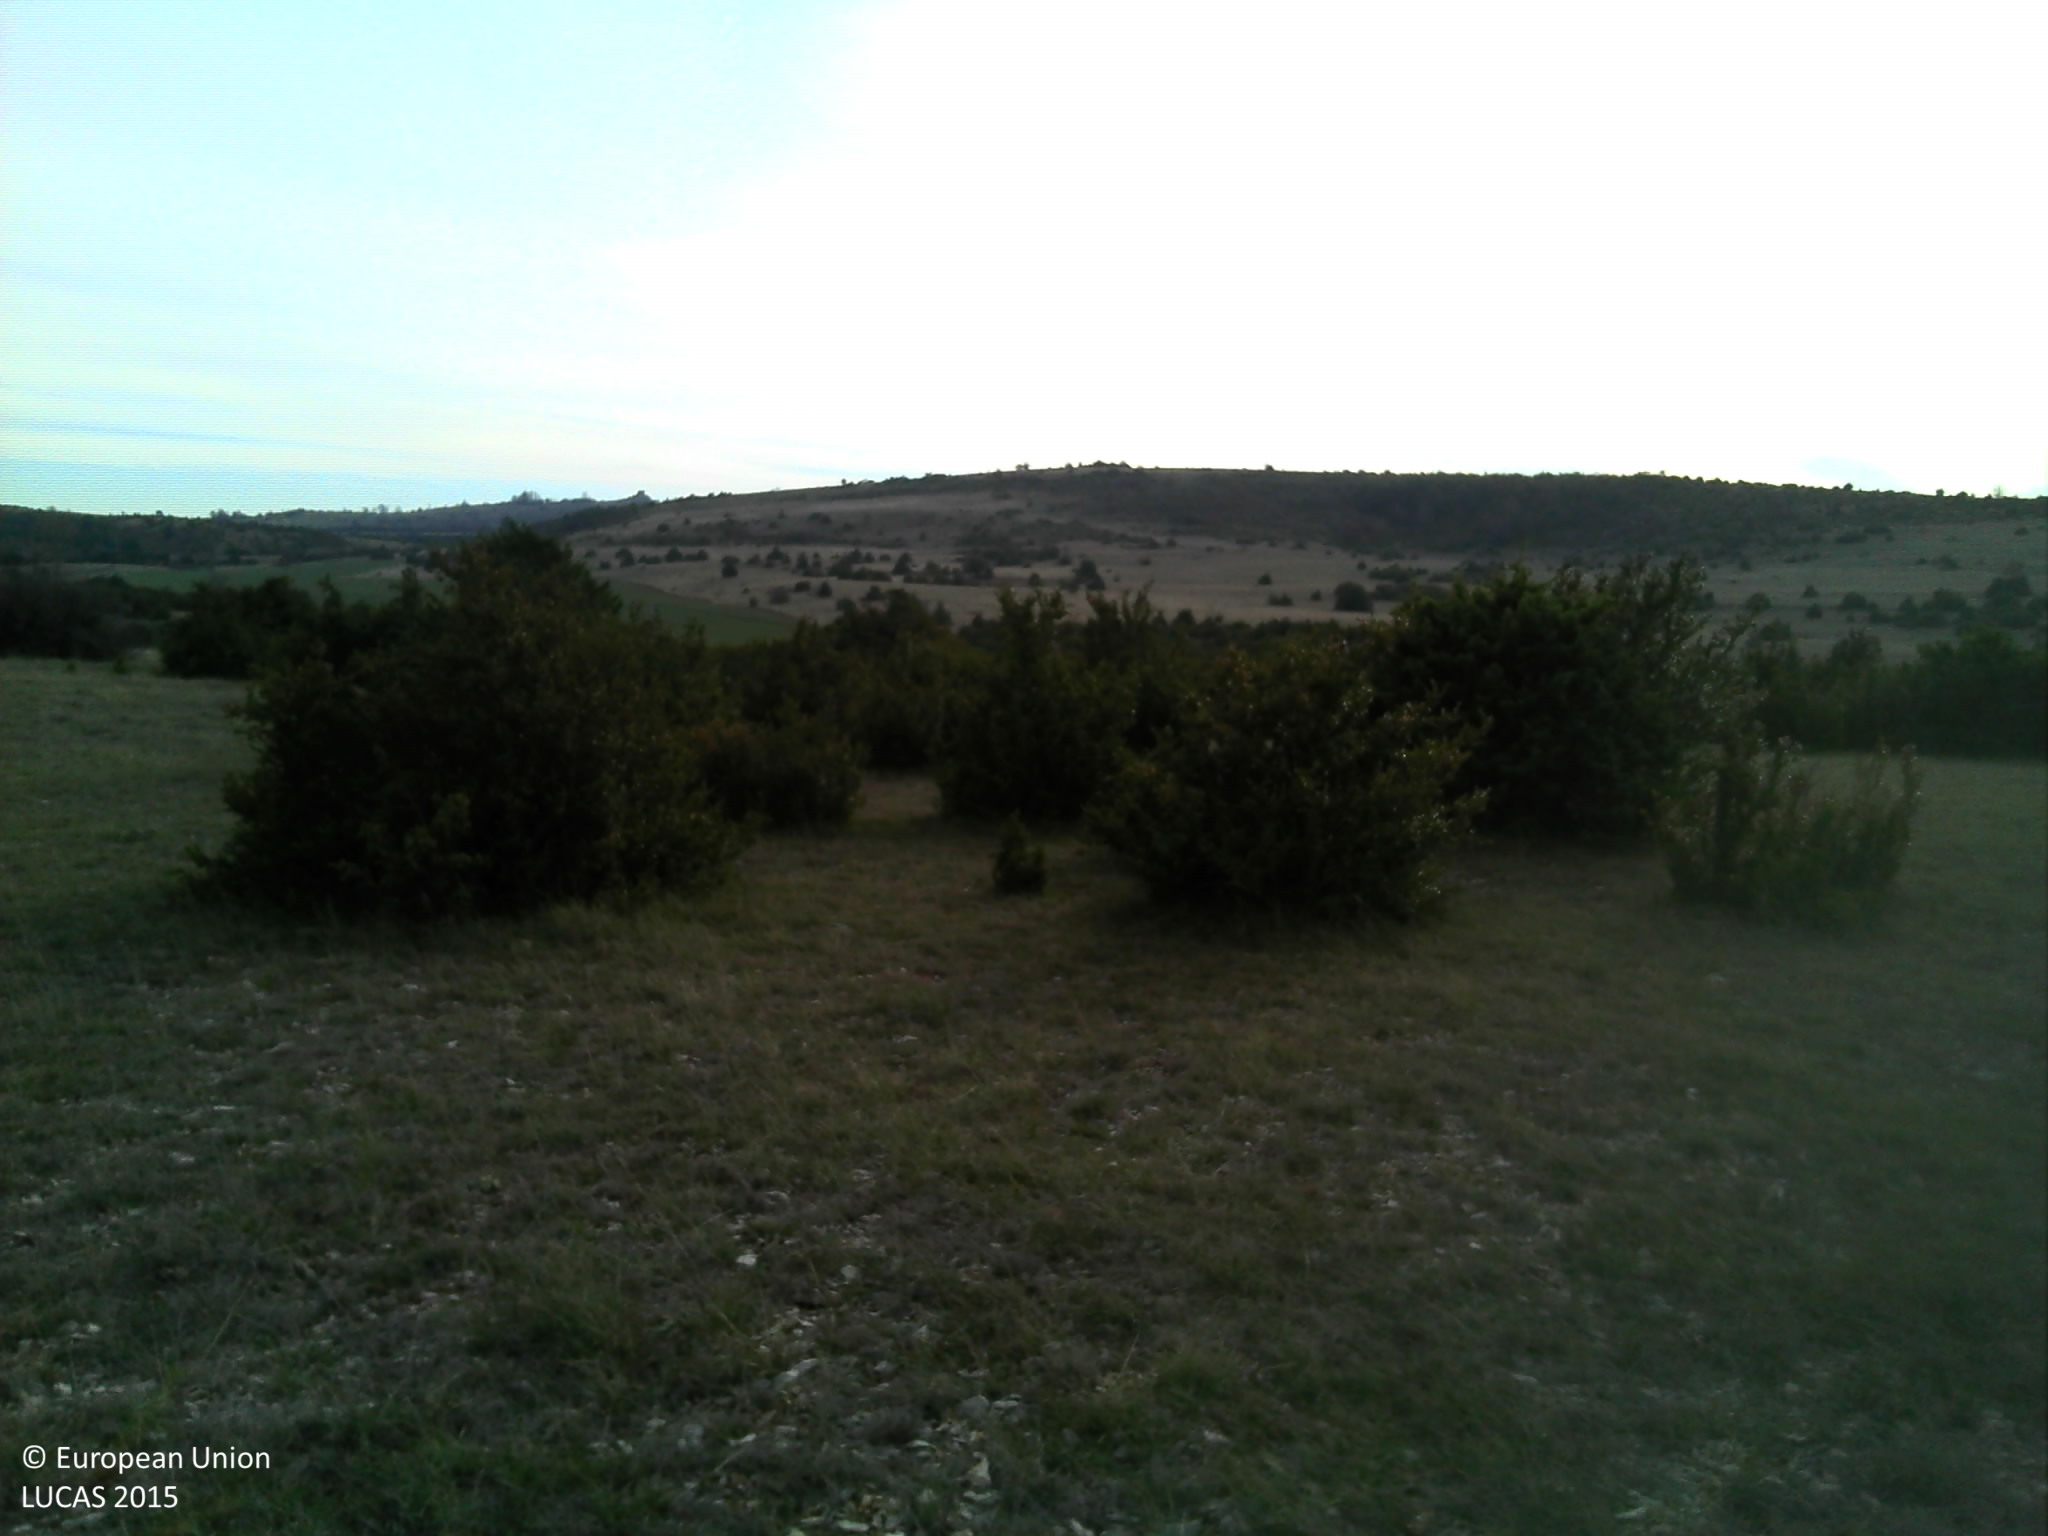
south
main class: Shrubland
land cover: Shrubland with sparse tree cover
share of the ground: > 75 %
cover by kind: herbaceous plants 70 %, shrubs 15 %, broadleaved forest trees 5 %, consolidated bare surface 5 %, unconsolidated bare surface 5 %
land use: Agriculture (excluding fallow land and kitchen gardens)
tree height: < 5 m
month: November
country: FR
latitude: 44.0699
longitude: 3.1516
